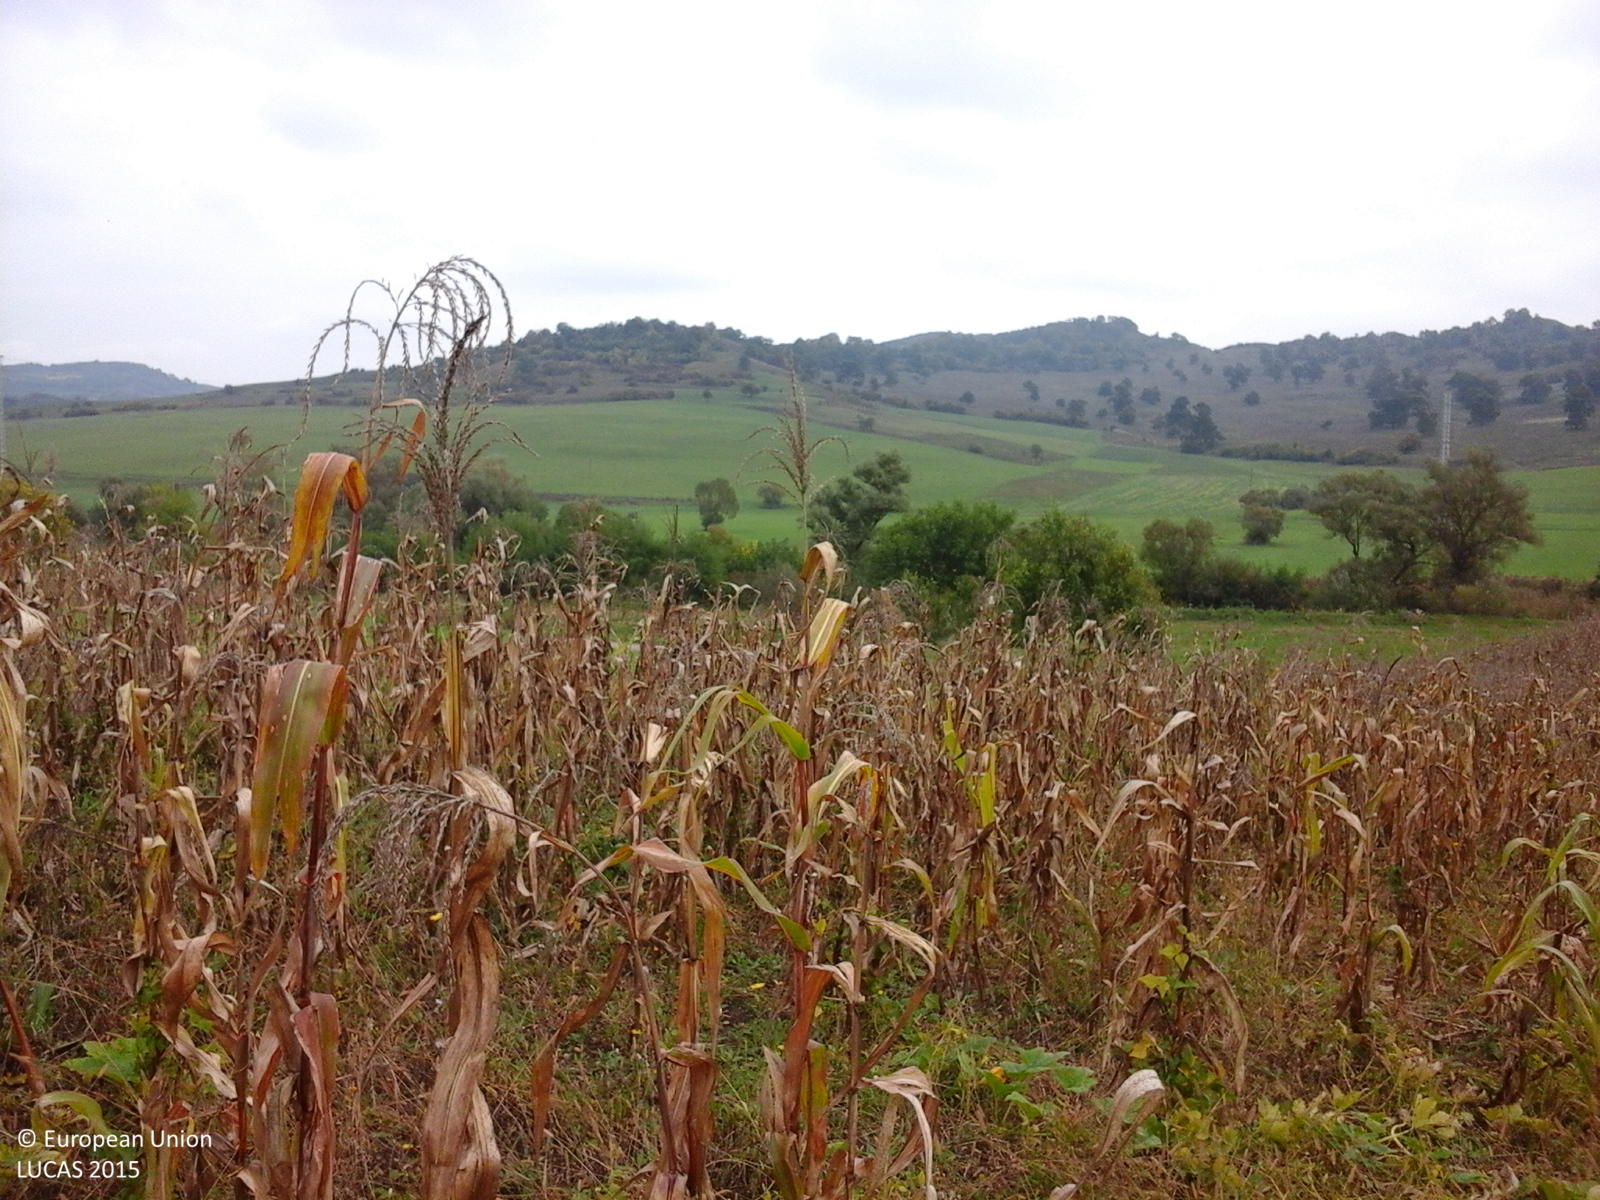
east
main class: Cropland
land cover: Maize
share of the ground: 25 - 50 %
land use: Agriculture (excluding fallow land and kitchen gardens)
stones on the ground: < 10 %
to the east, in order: Maize; Other fresh vegetables; Grassland without tree/shrub cover; Grassland with sparse tree/shrub cover; Ditches and canals; Grass margins; Paved roads, cycling and walking lanes; Grassland without tree/shrub cover; Common wheat; Maize; Grassland with sparse tree/shrub cover; Maize; Shruby margins; Broadleaved woodland; Ditches and canals; Broadleaved woodland; Shruby margins; Grassland without tree/shrub cover
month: October
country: RO
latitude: 46.2669
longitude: 24.9244
